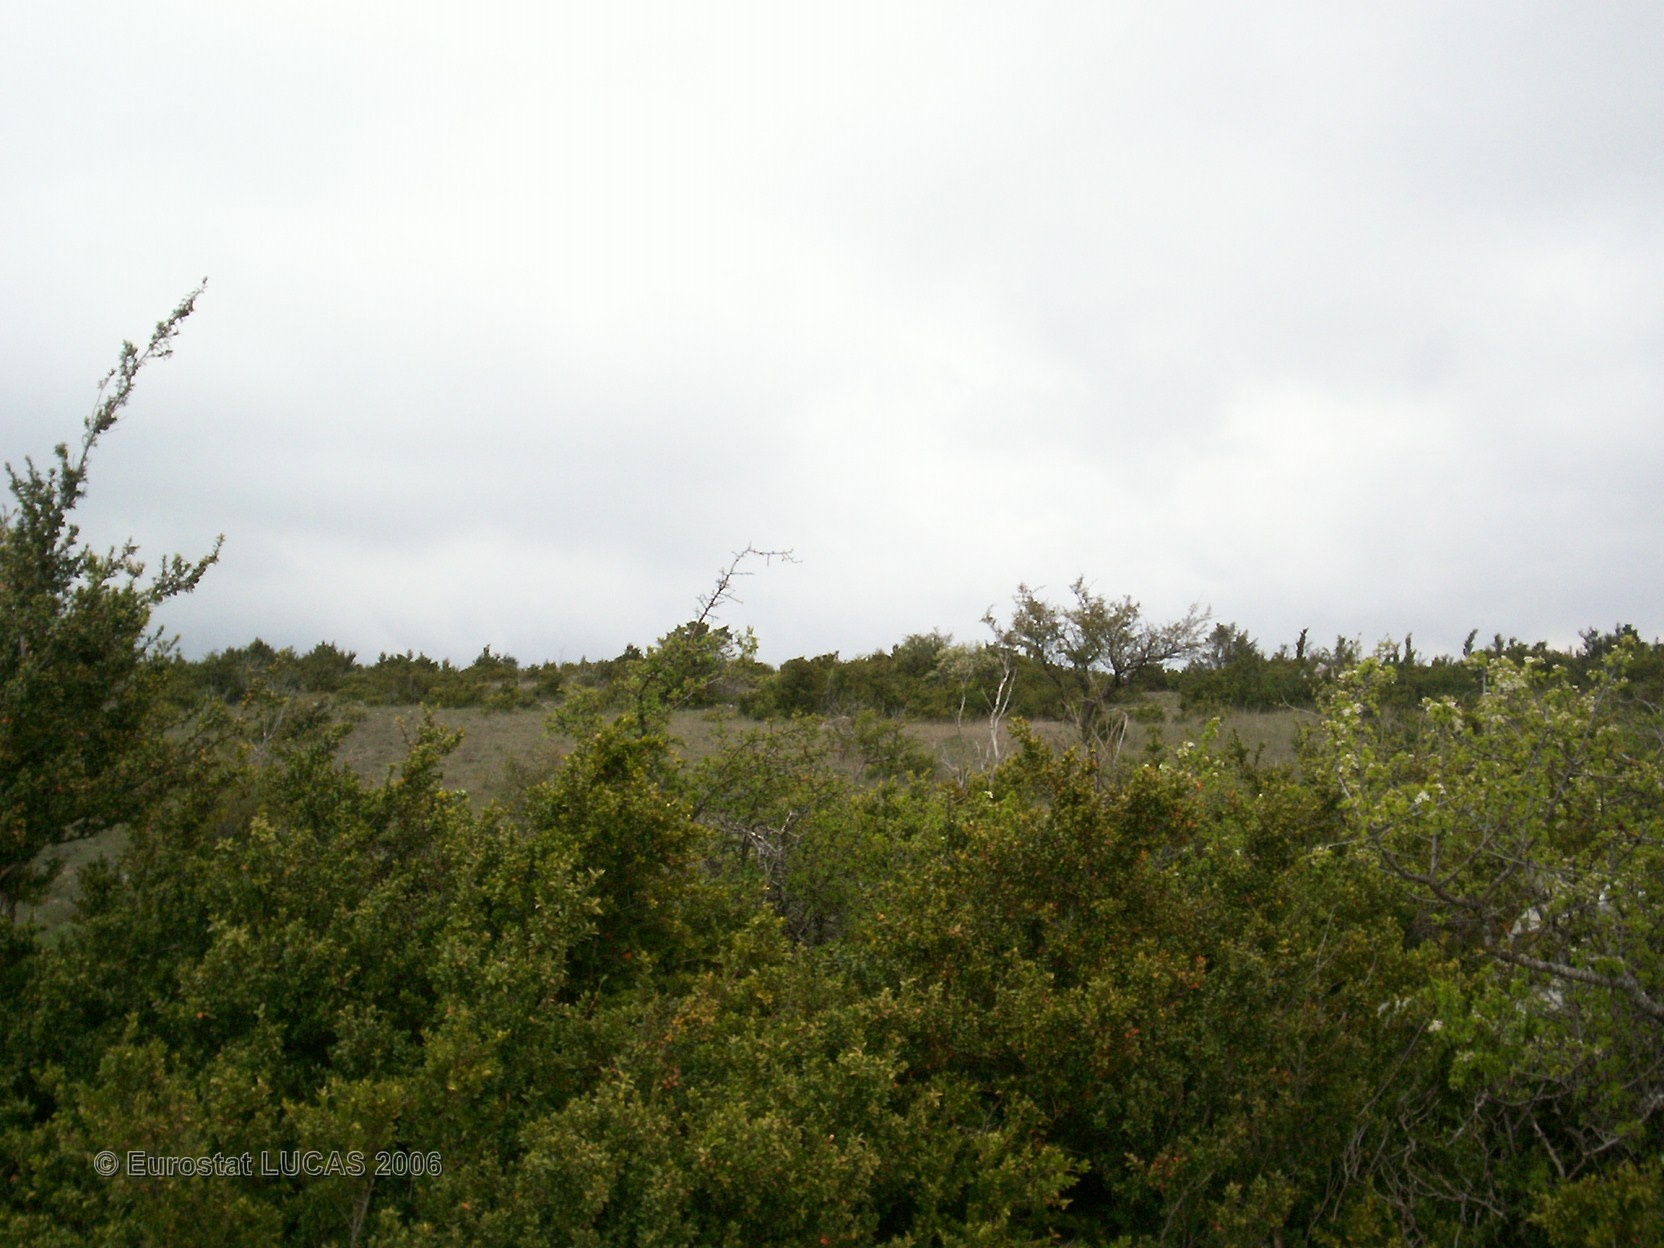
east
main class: Grassland
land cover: Grassland with sparse tree/shrub cover
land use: Agriculture (excluding fallow land and kitchen gardens)
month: May
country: FR
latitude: 43.8510
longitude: 3.4021
